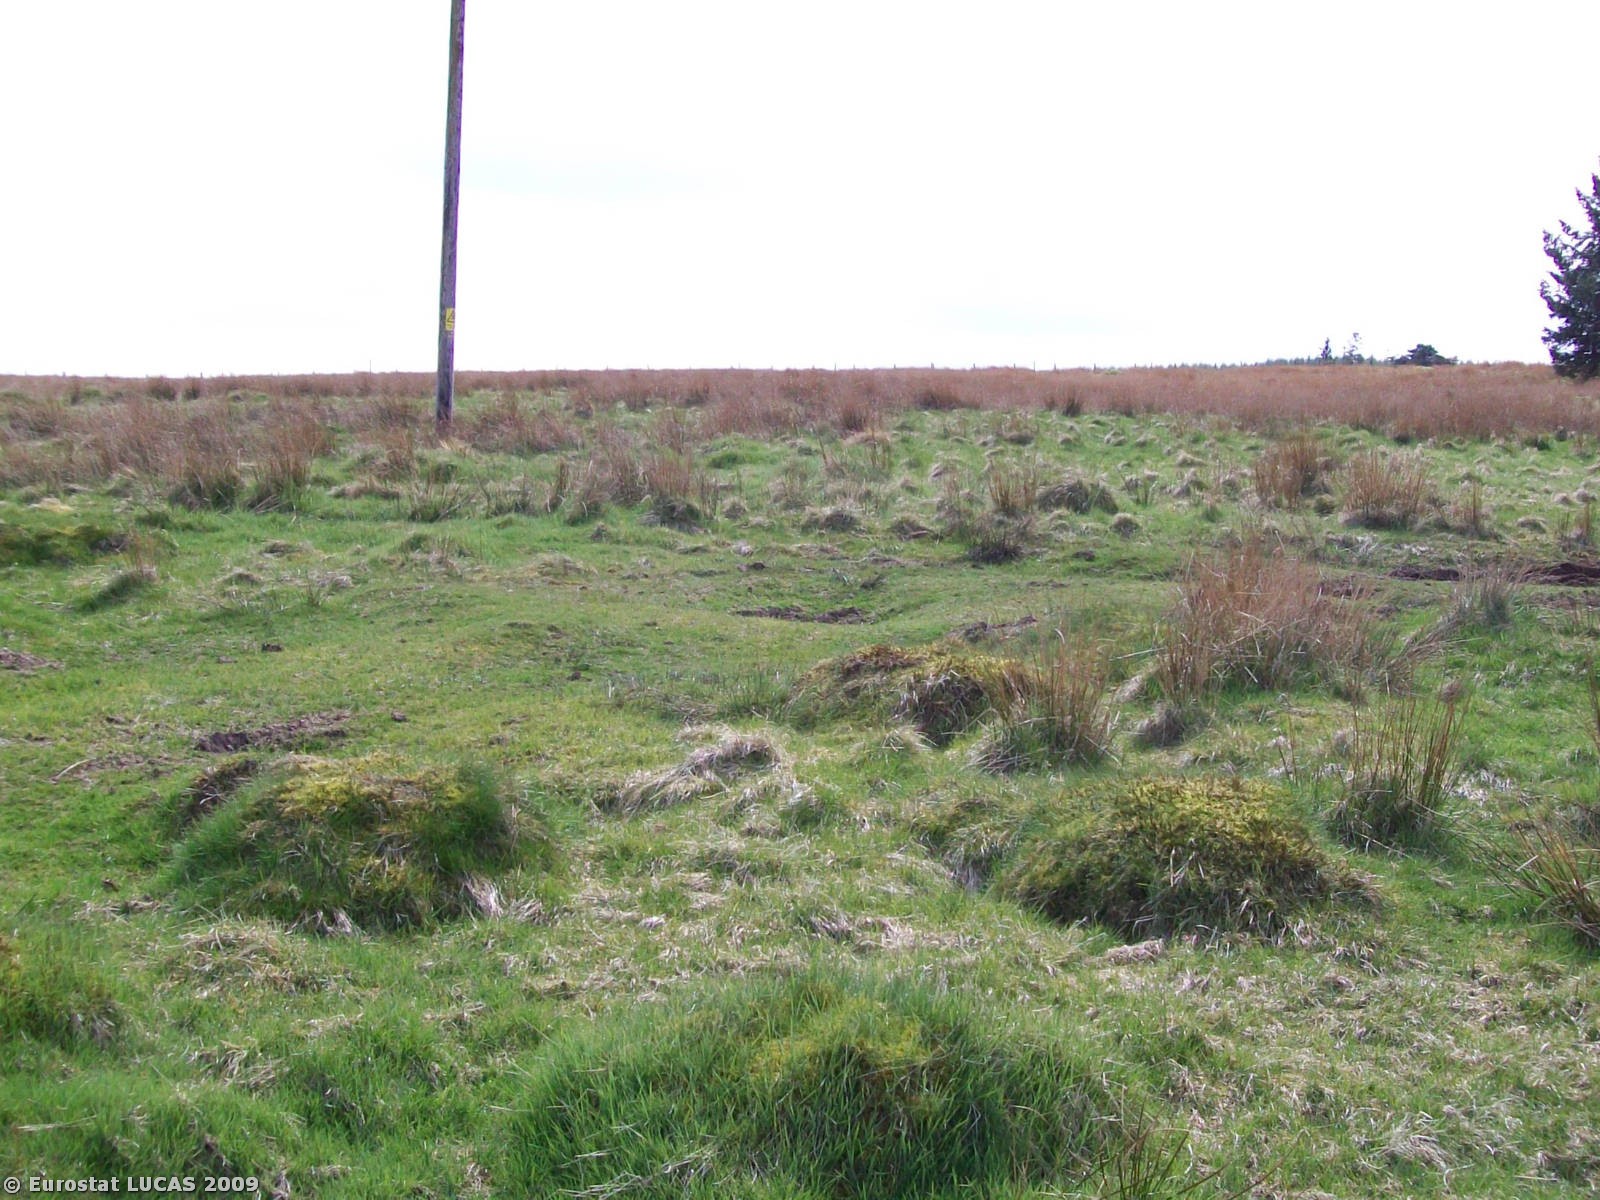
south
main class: Grassland
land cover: Grassland with sparse tree/shrub cover
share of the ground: > 75 %
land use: Agriculture (excluding fallow land and kitchen gardens)
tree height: > 5 m
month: April
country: GB
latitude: 56.2960
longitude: -3.8006
